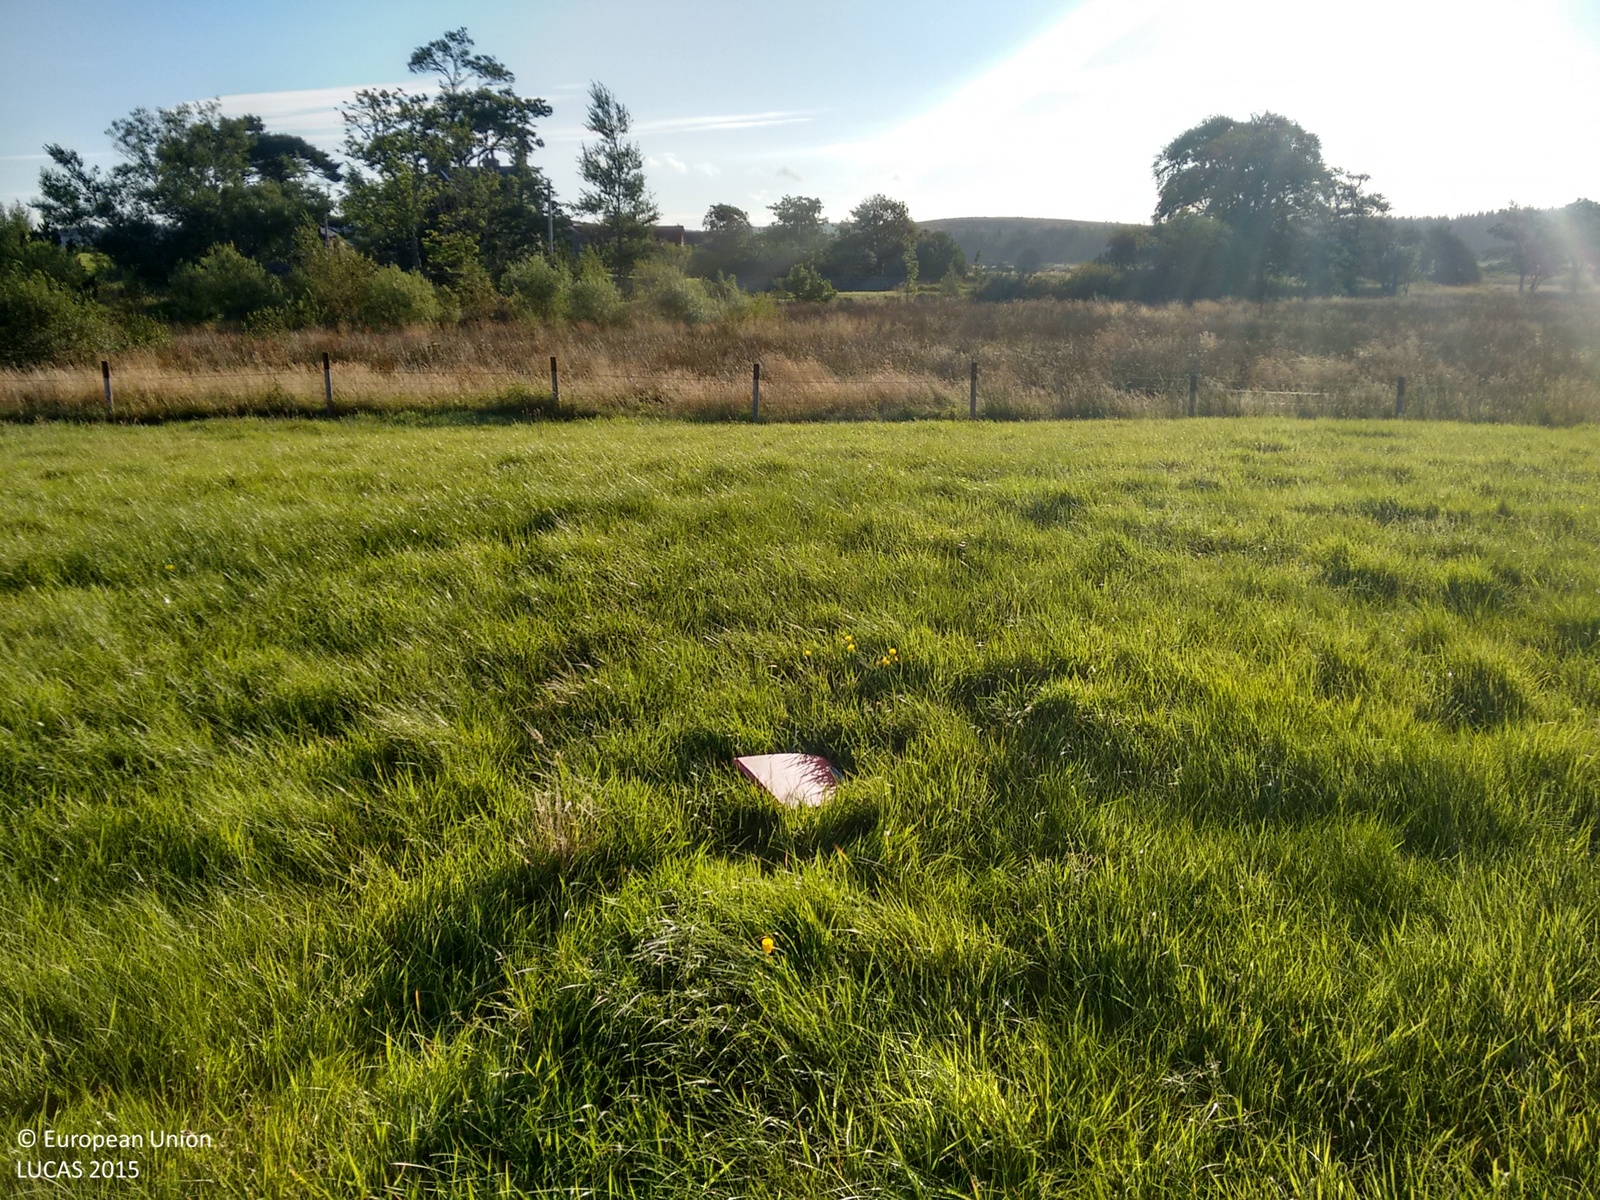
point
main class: Grassland
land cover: Grassland without tree/shrub cover
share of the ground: > 75 %
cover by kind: herbaceous plants 100 %
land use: Residential
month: September
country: GB
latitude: 58.0567
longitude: -4.4398
